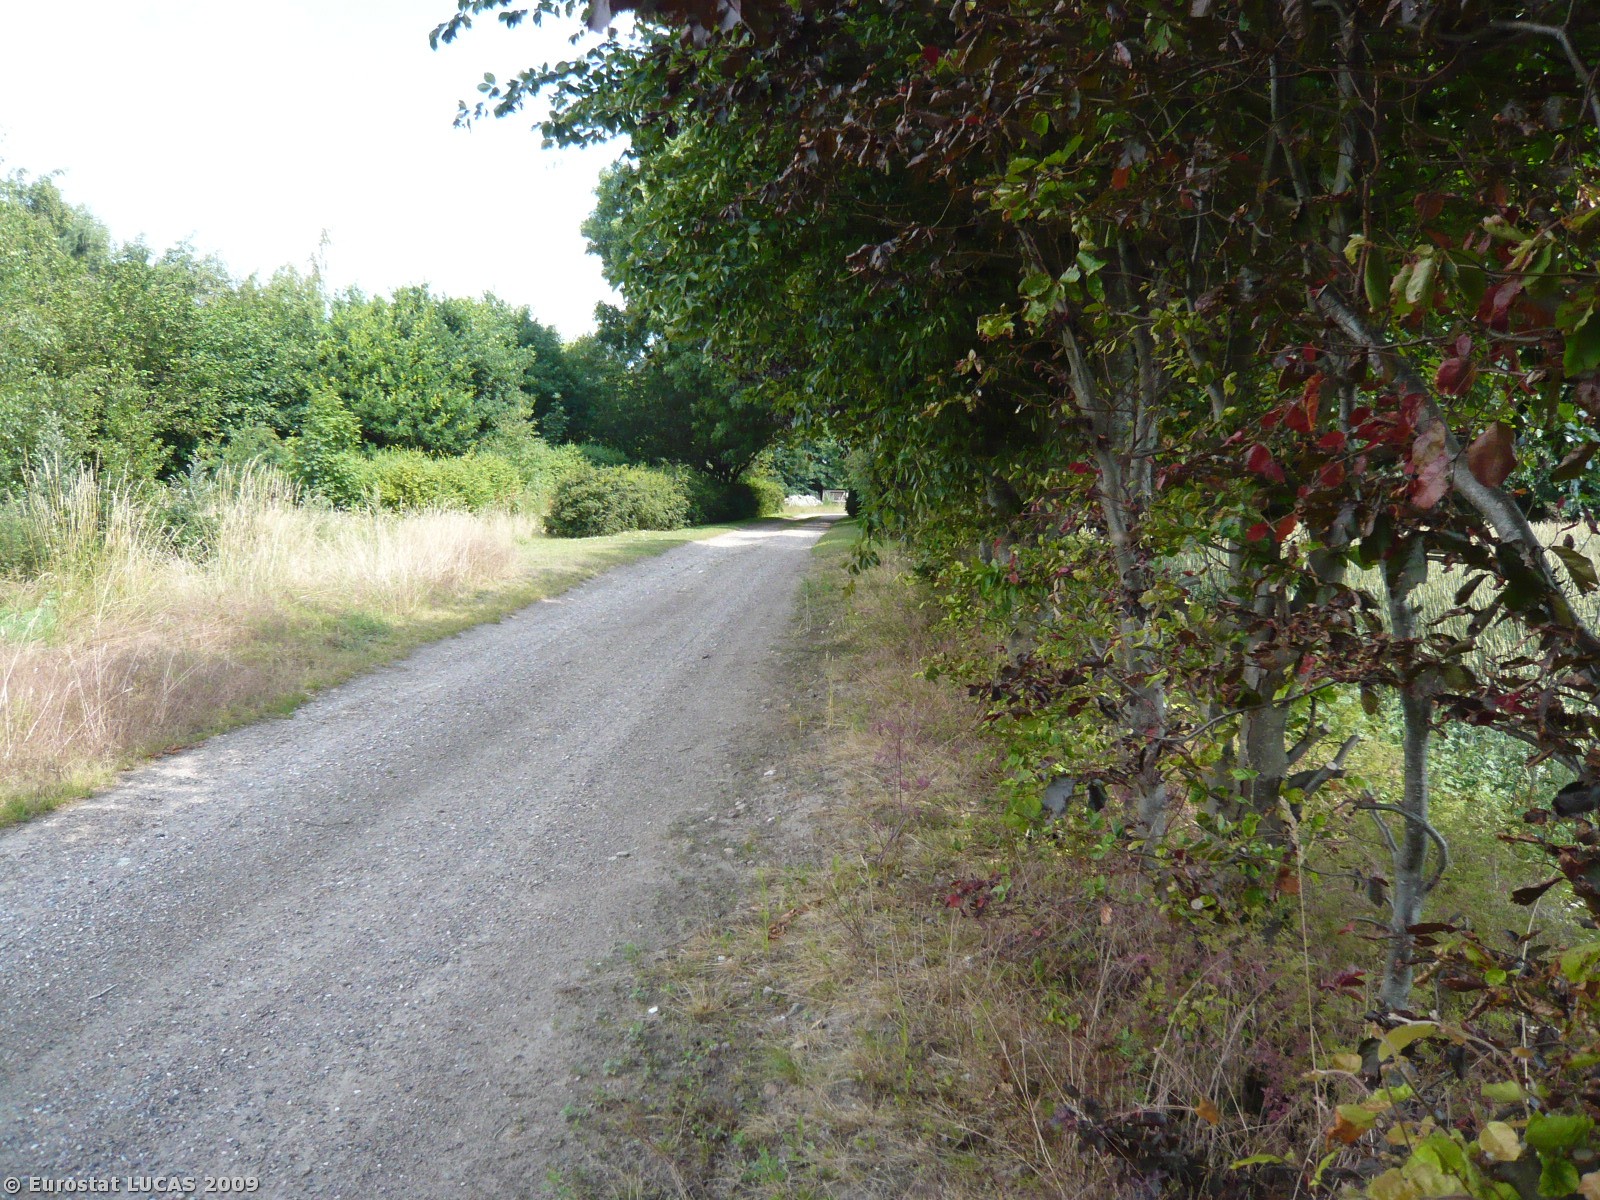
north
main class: Woodland
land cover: Broadleaved woodland
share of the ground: > 75 %
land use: Unused
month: July
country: DK
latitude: 55.8013
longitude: 11.5140
